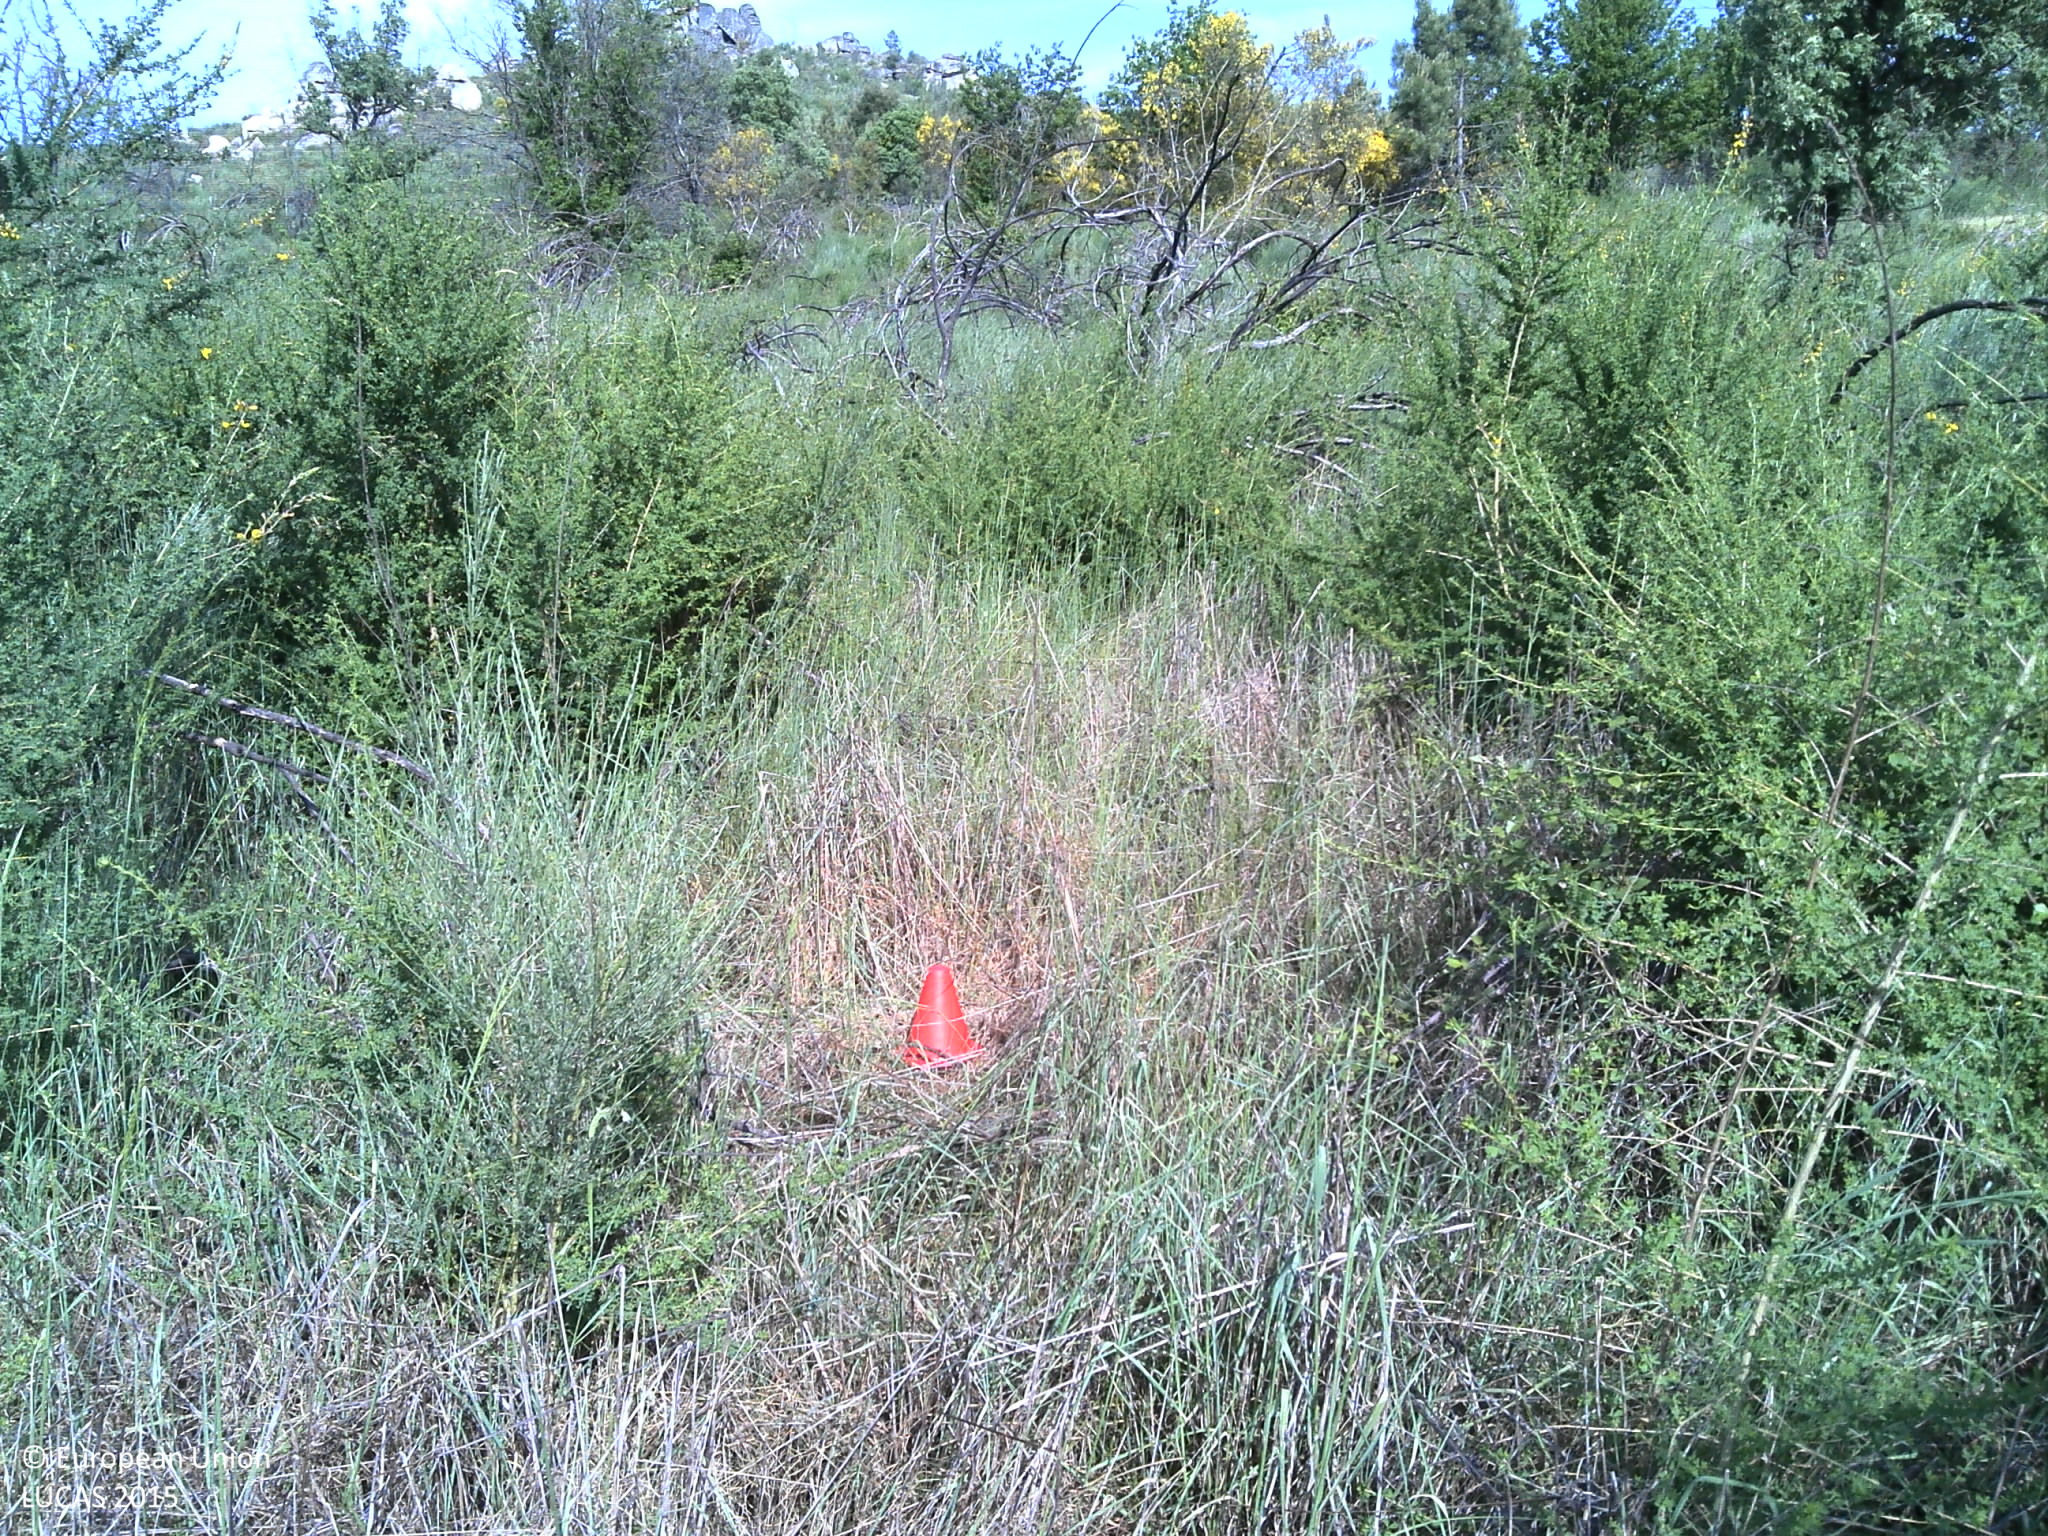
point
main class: Shrubland
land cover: Shrubland without tree cover
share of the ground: > 75 %
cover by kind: shrubs 60 %, herbaceous plants 40 %
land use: Forestry
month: May
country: PT
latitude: 41.6637
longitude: -7.5328
